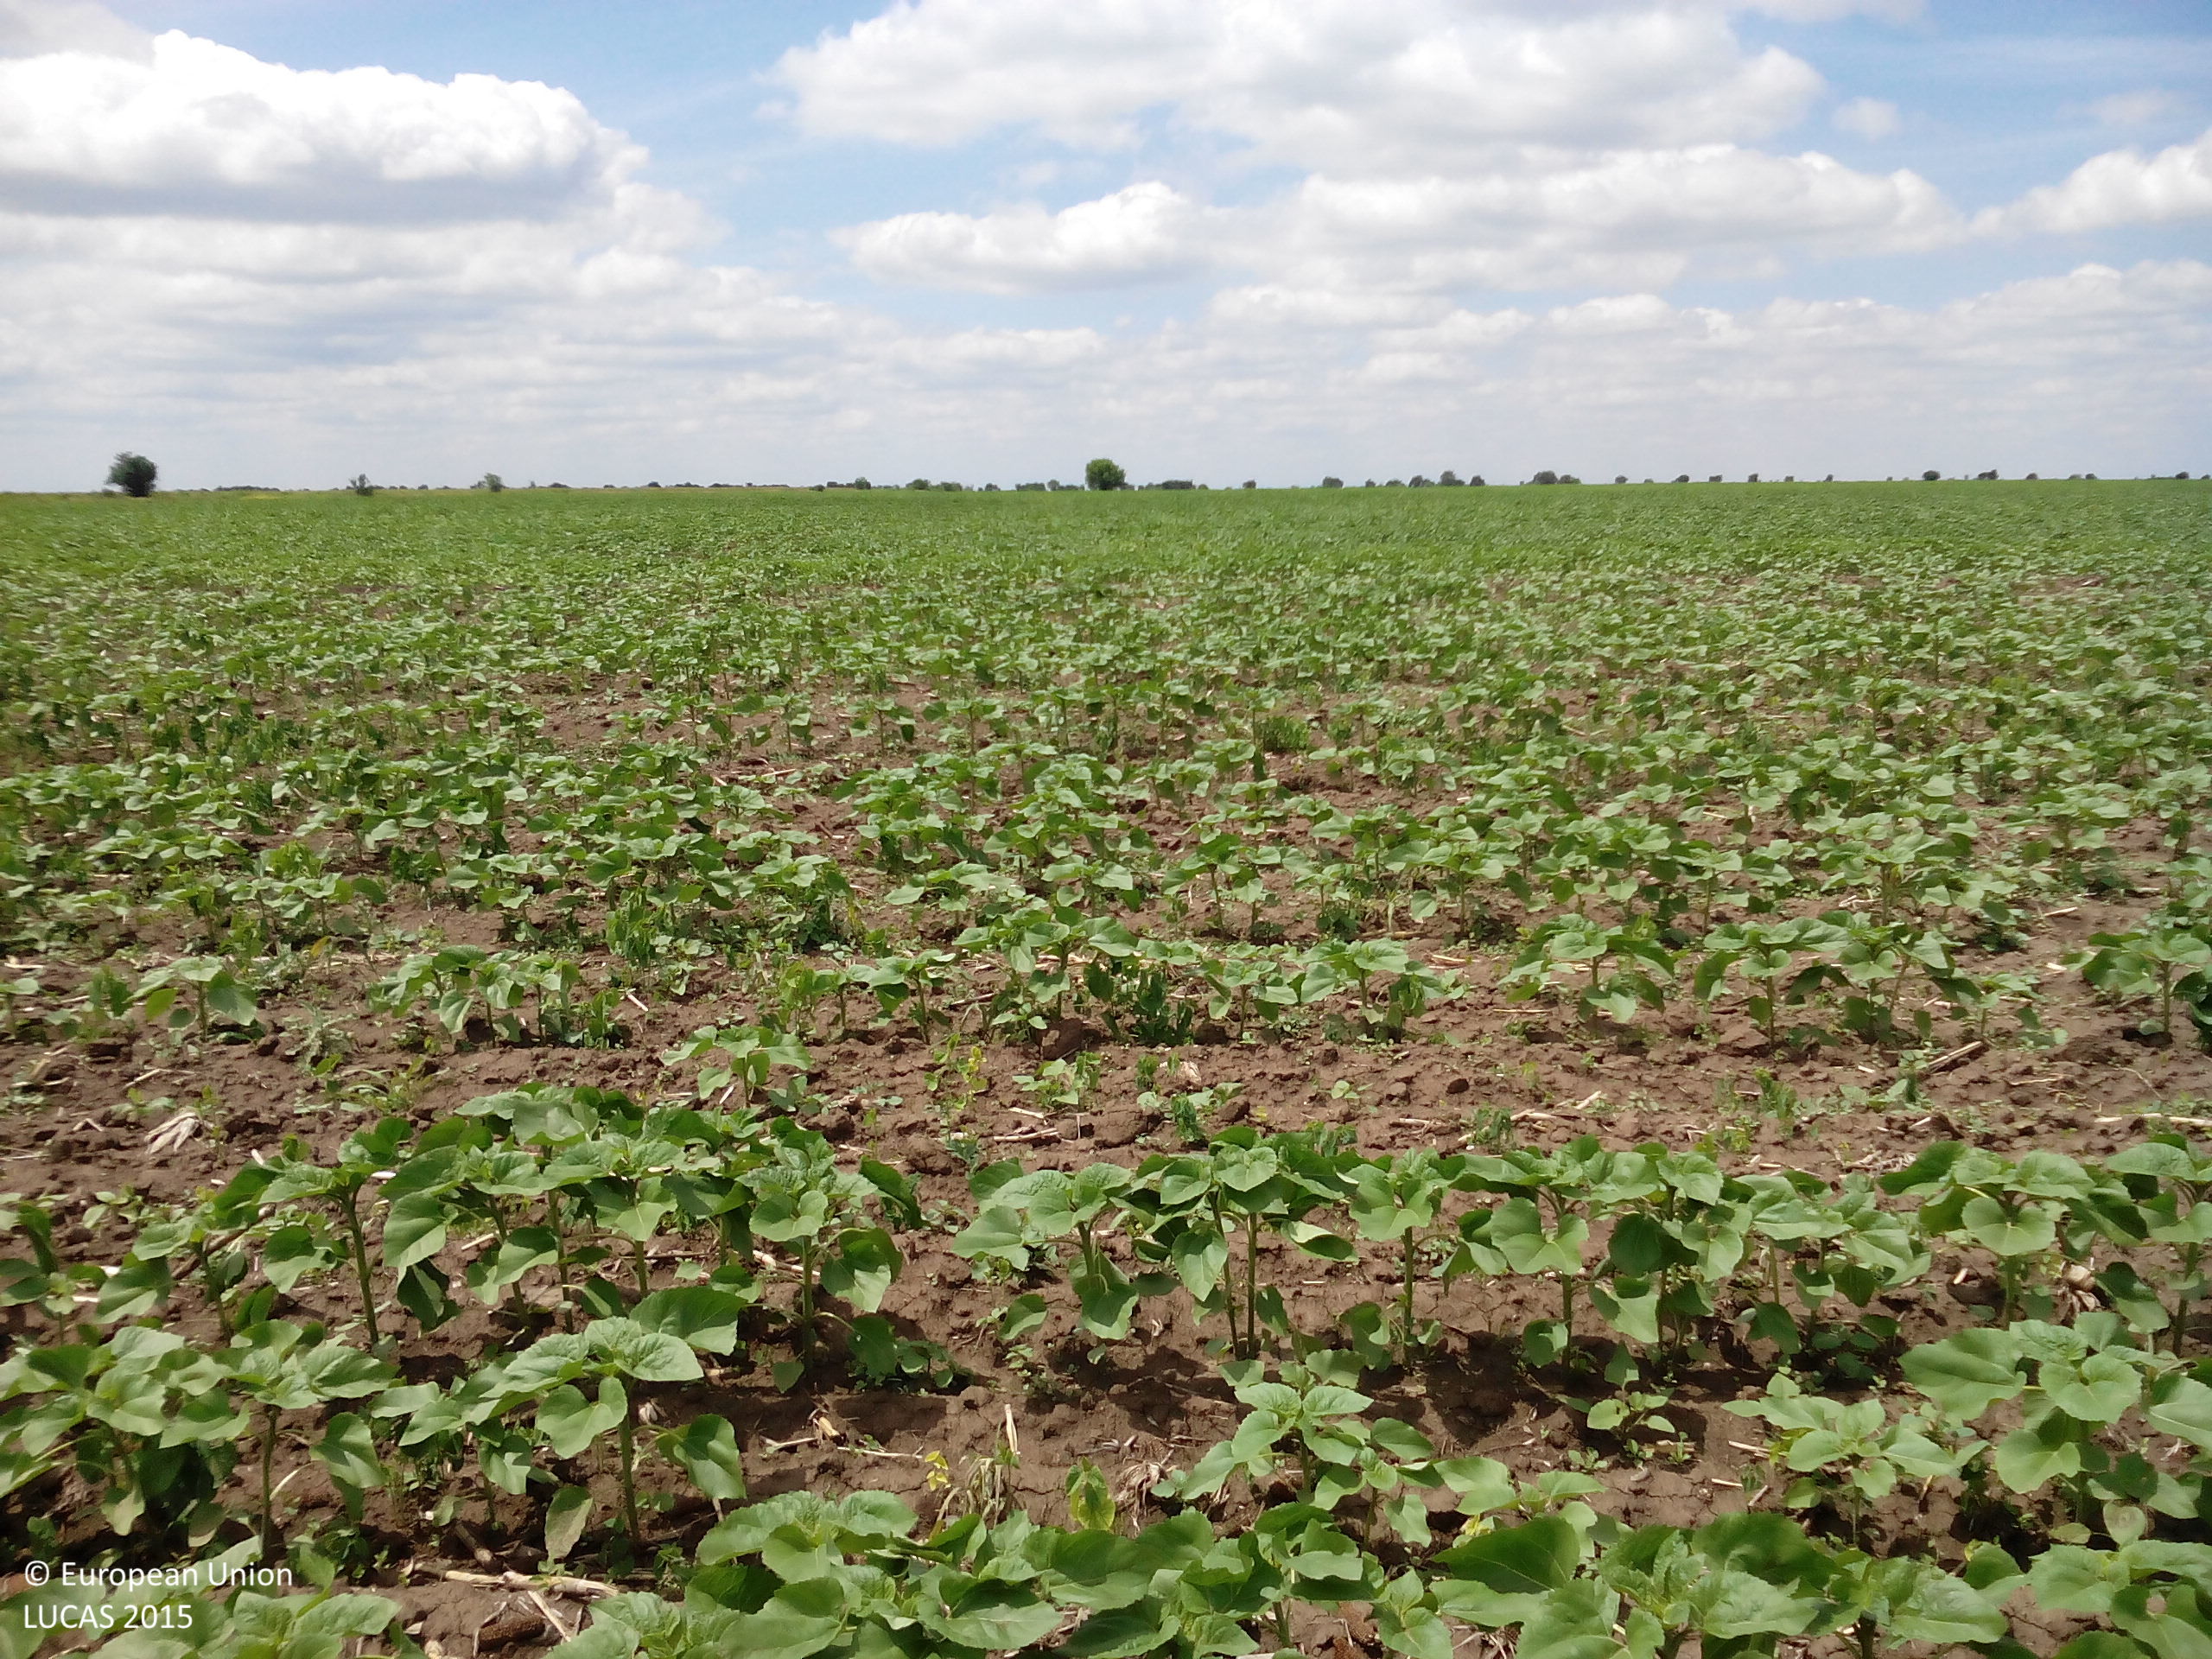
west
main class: Cropland
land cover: Sunflower
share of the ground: 50 - 75 %
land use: Agriculture (excluding fallow land and kitchen gardens)
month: May
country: BG
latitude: 43.5043
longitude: 24.1428
